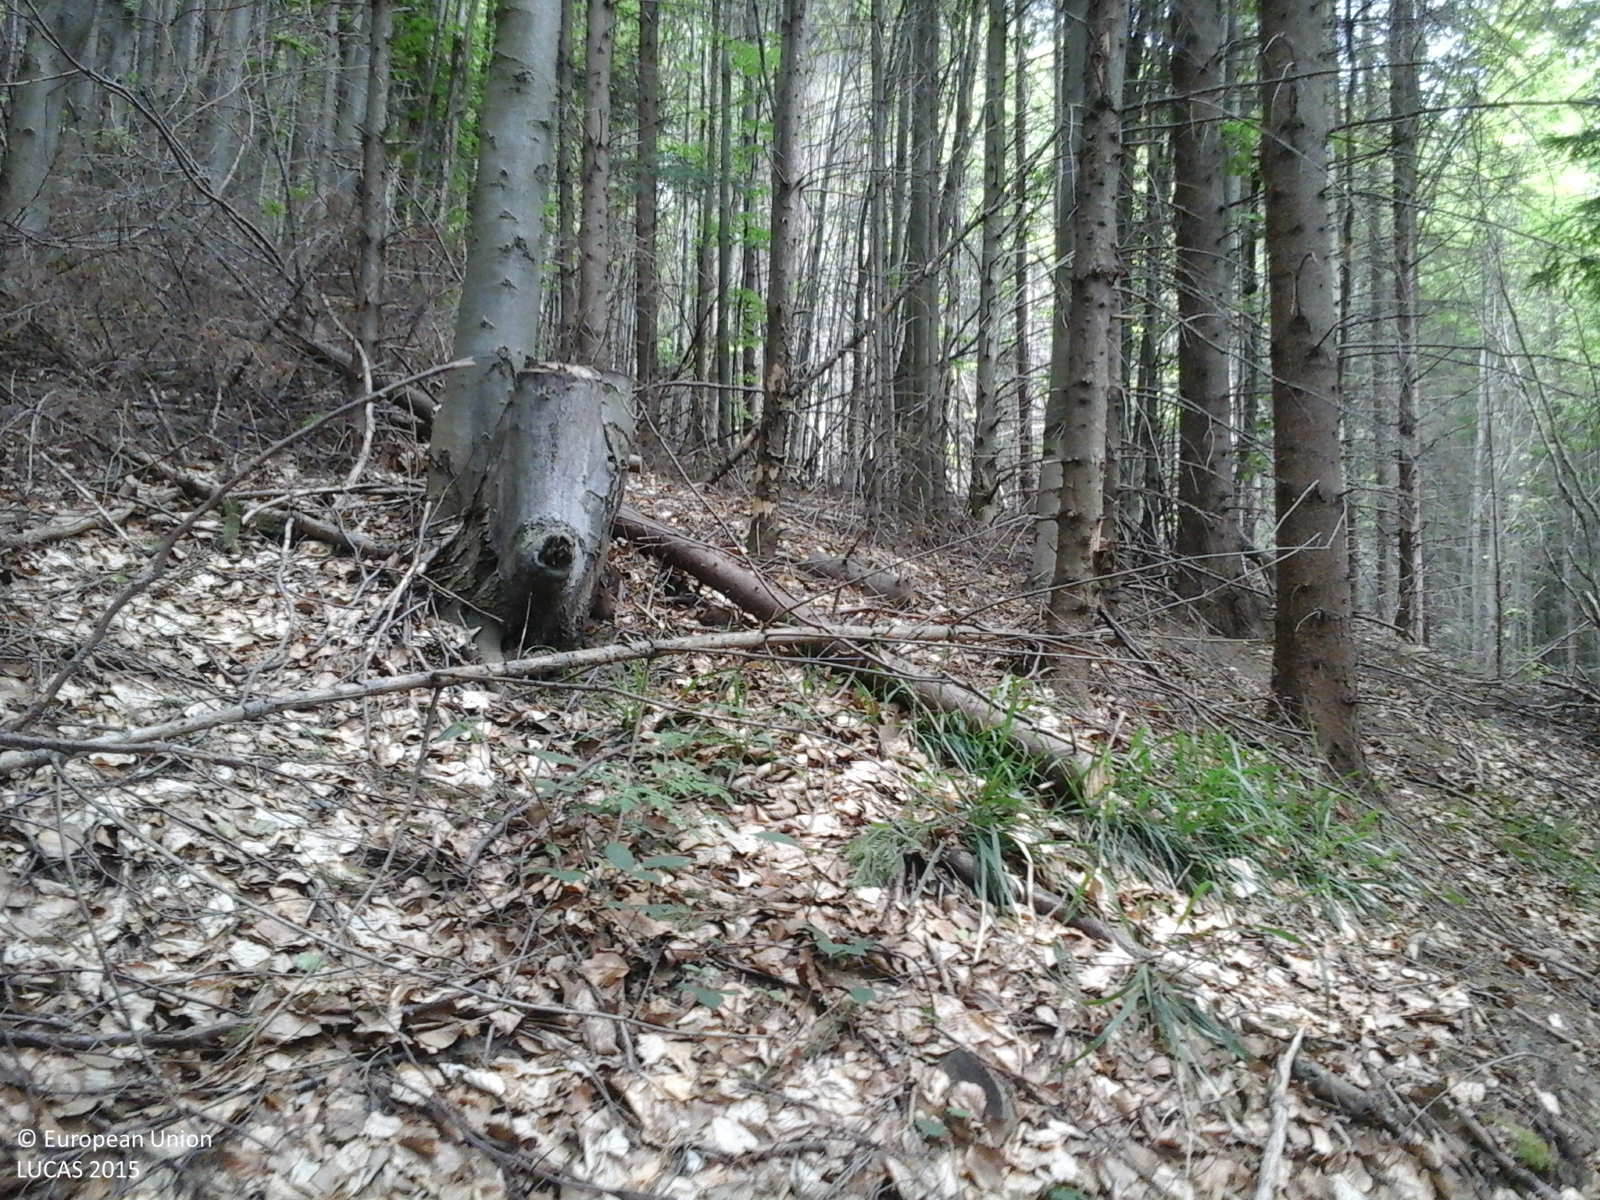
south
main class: Woodland
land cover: Other mixed woodland
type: mountainous beech forest
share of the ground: > 75 %
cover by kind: coniferous forest trees 60 %, broadleaved forest trees 40 %
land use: Forestry
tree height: > 5 m
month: May
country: RO
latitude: 46.0965
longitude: 26.4401
